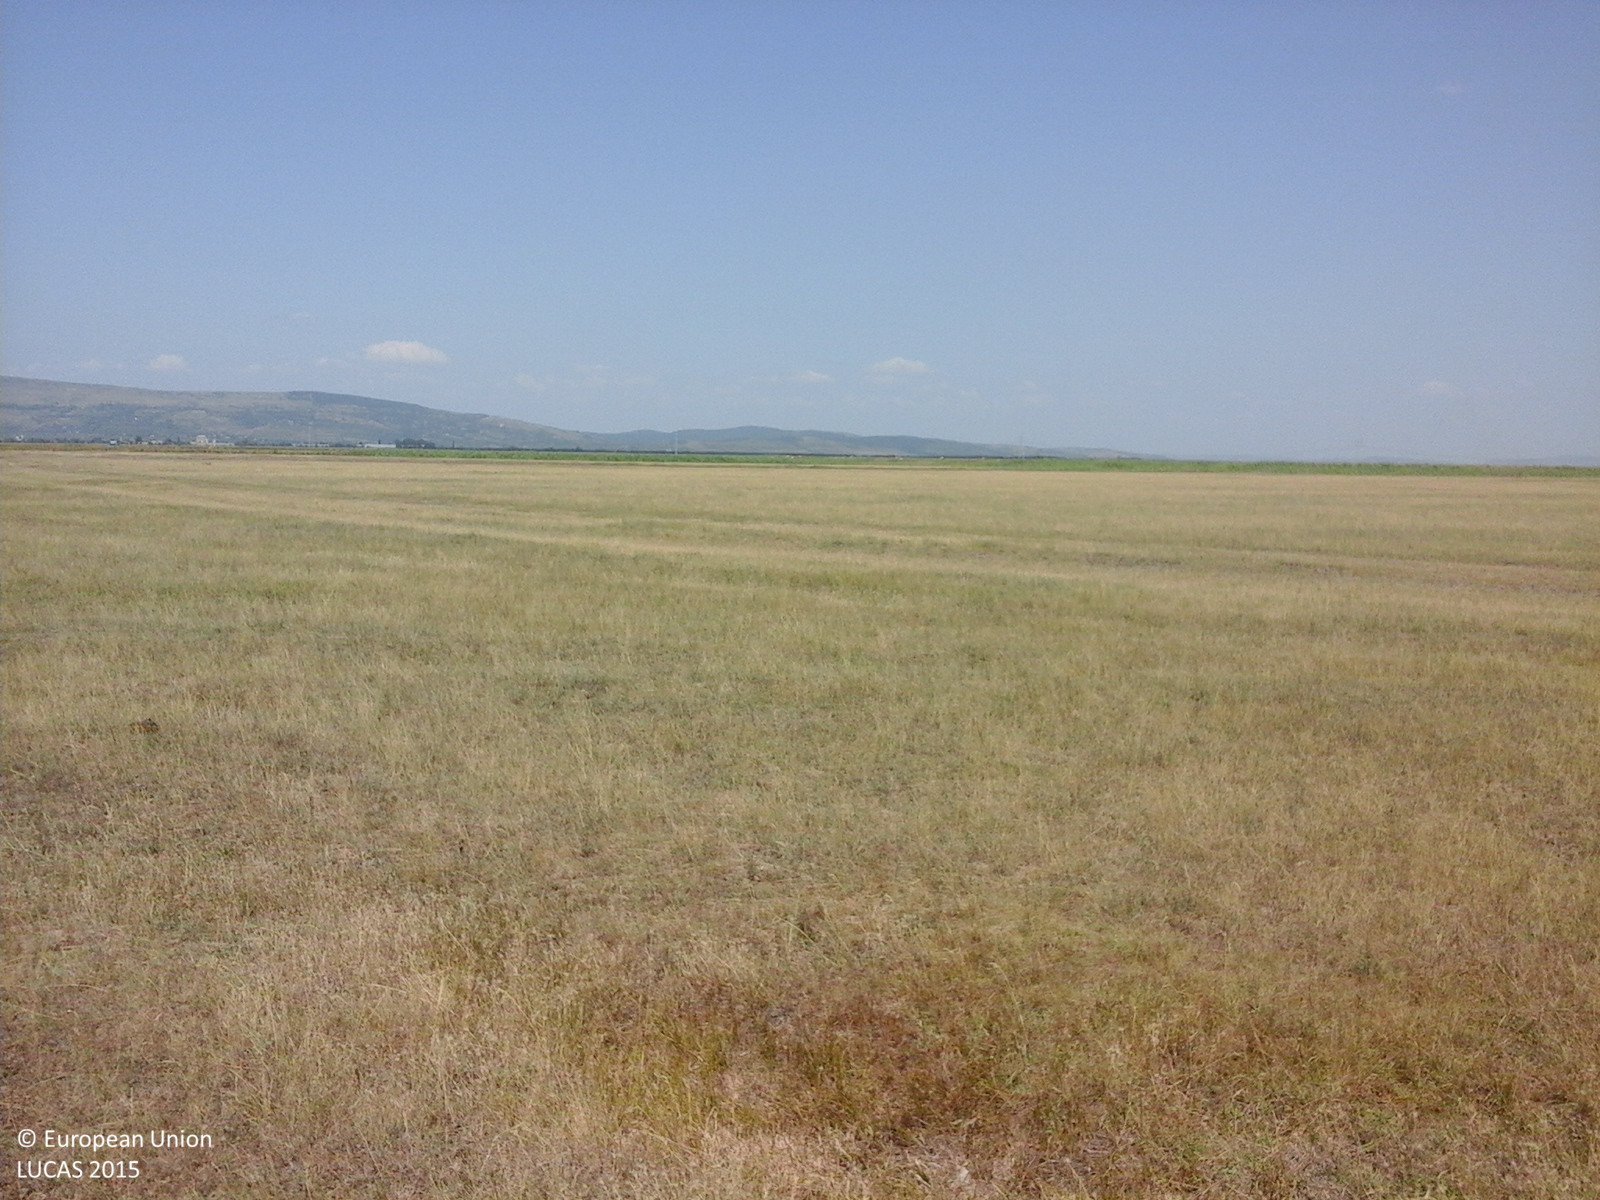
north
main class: Grassland
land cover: Grassland without tree/shrub cover
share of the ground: > 75 %
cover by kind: herbaceous plants 100 %
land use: Agriculture (excluding fallow land and kitchen gardens)
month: July
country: RO
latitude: 45.0496
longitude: 26.6697
